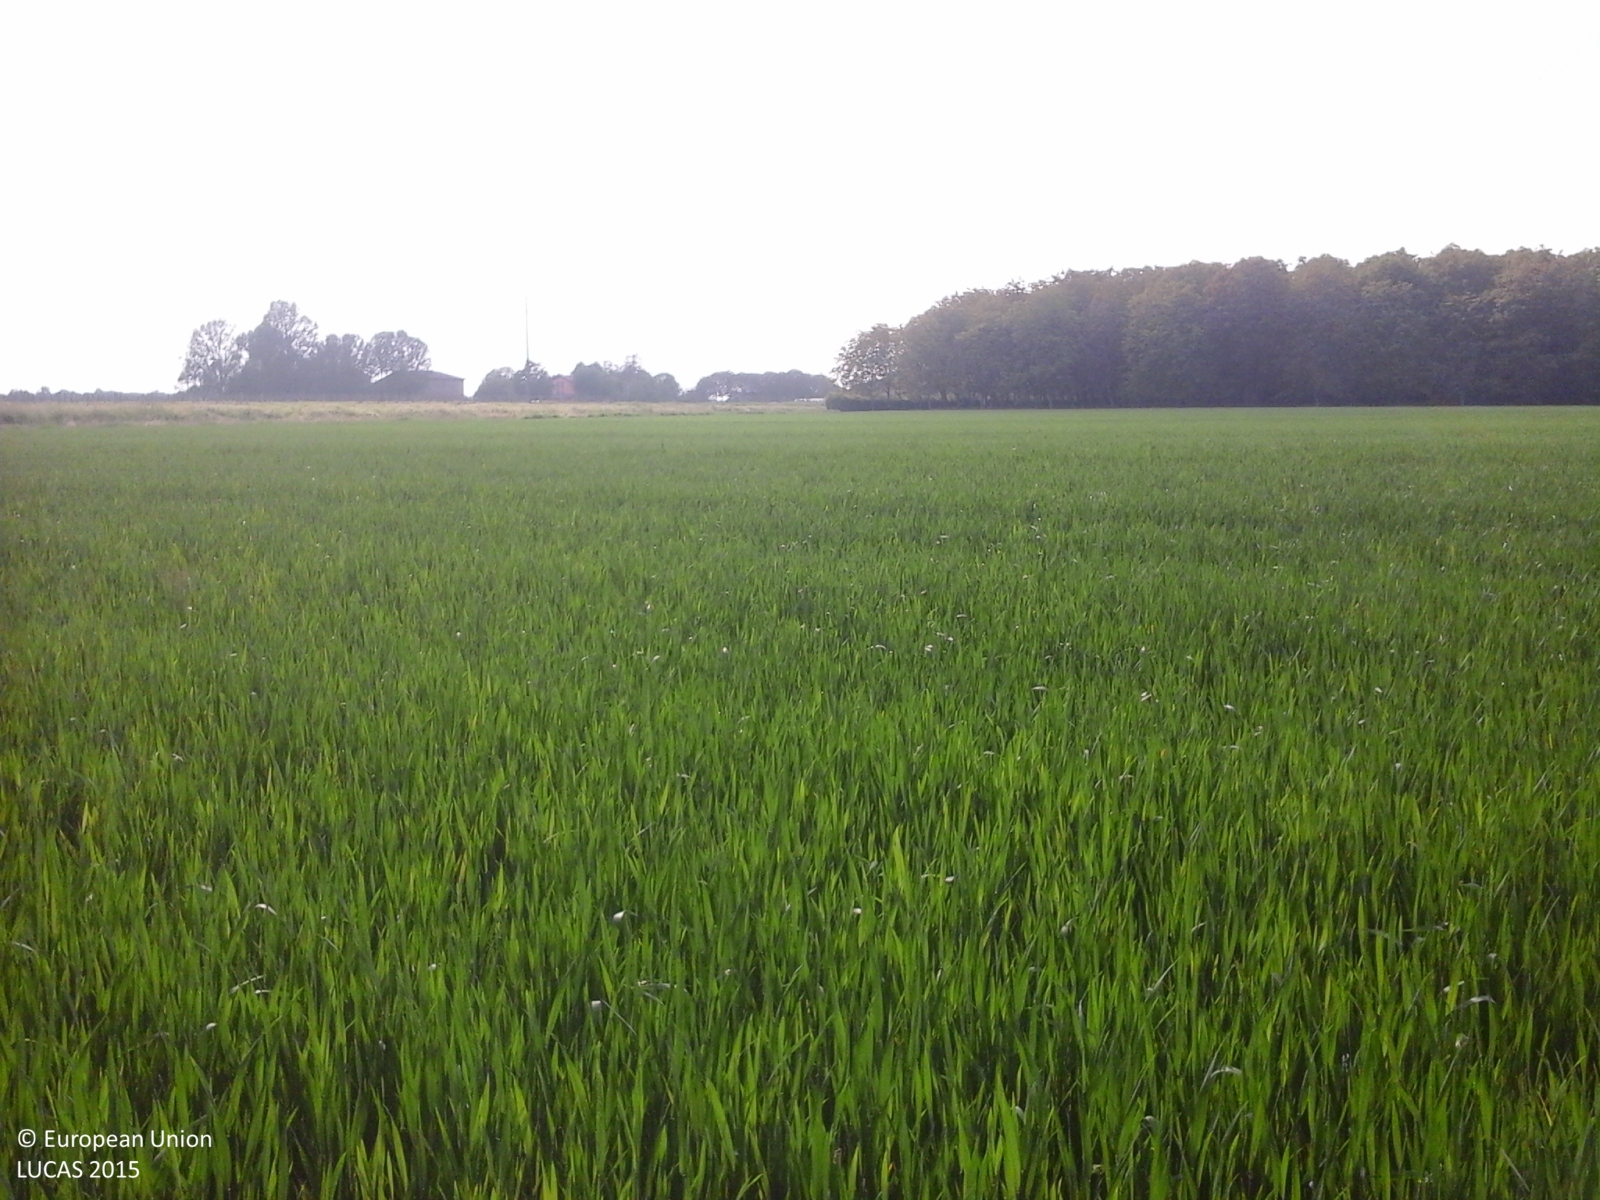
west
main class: Cropland
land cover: Common wheat
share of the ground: > 75 %
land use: Agriculture (excluding fallow land and kitchen gardens)
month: April
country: IT
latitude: 44.7256
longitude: 10.8694
